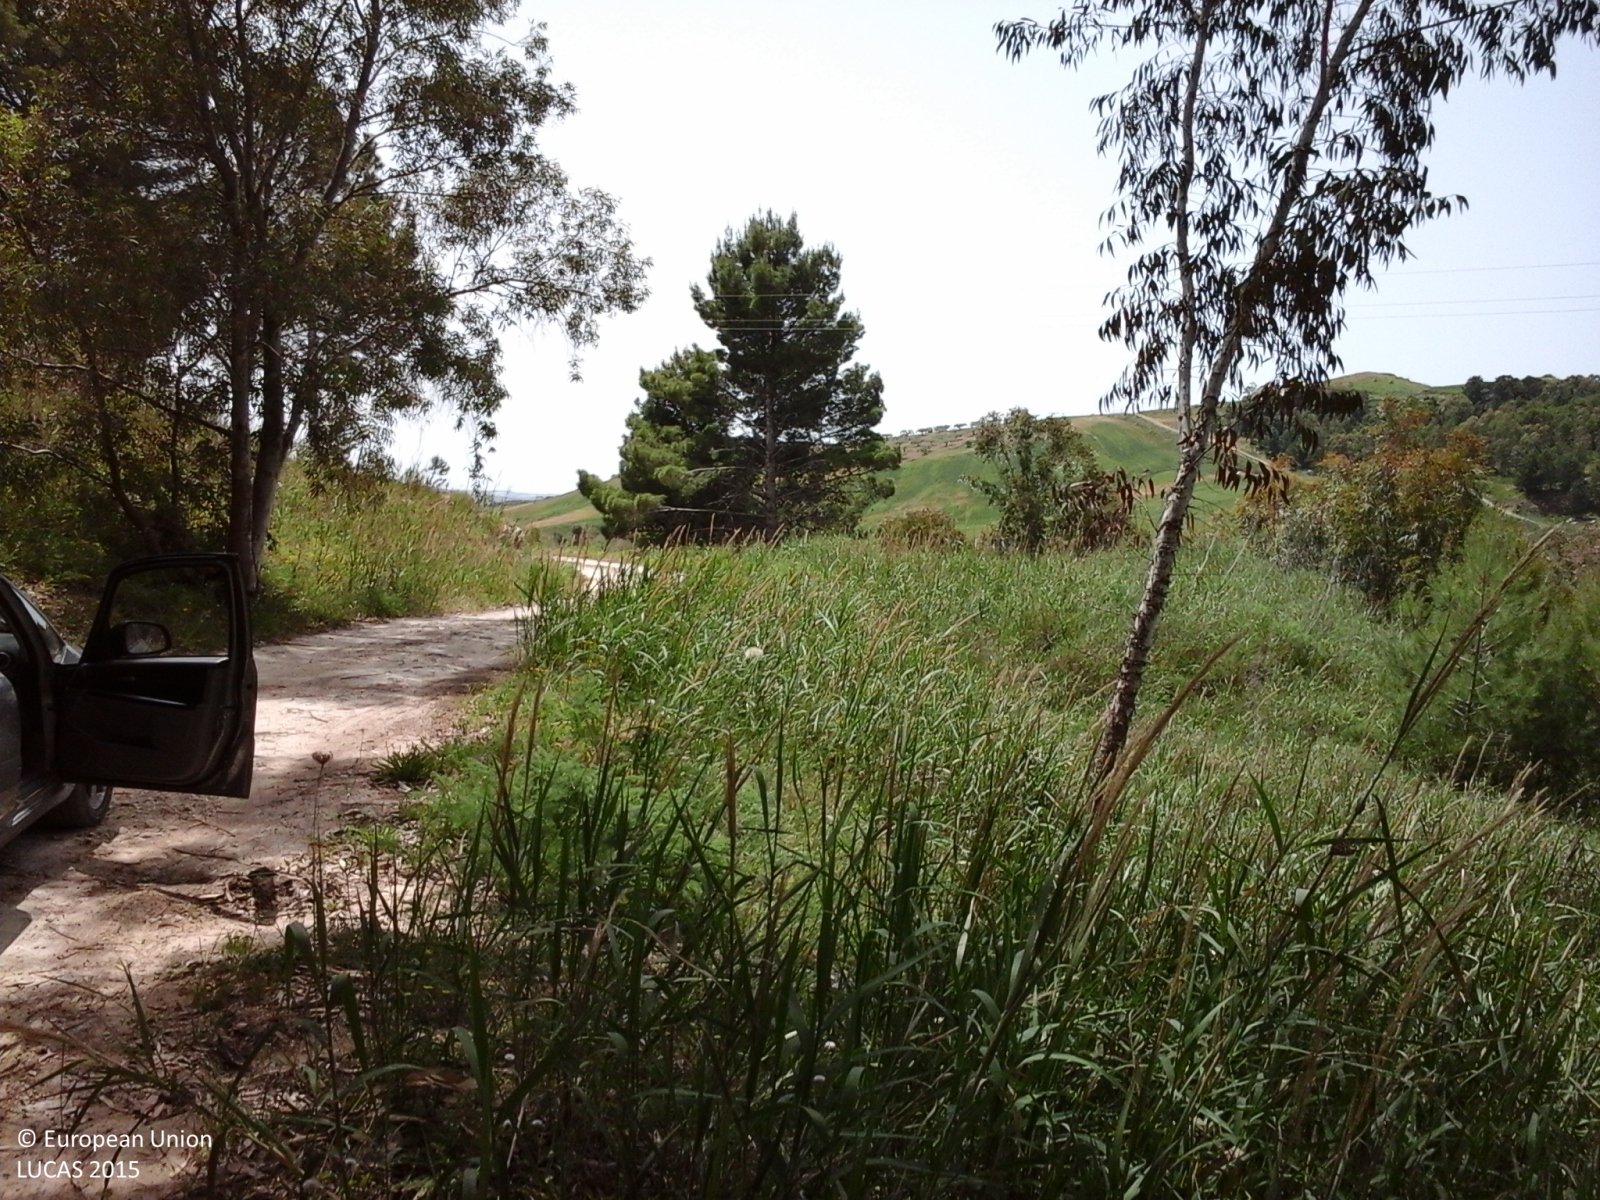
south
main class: Woodland
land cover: Broadleaved woodland
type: coniferous forest of the mediterranean region
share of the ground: > 75 %
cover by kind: broadleaved forest trees 70 %, coniferous forest trees 20 %, consolidated bare surface 10 %
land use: Forestry
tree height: < 5 m
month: May
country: IT
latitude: 37.5585
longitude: 13.8991
